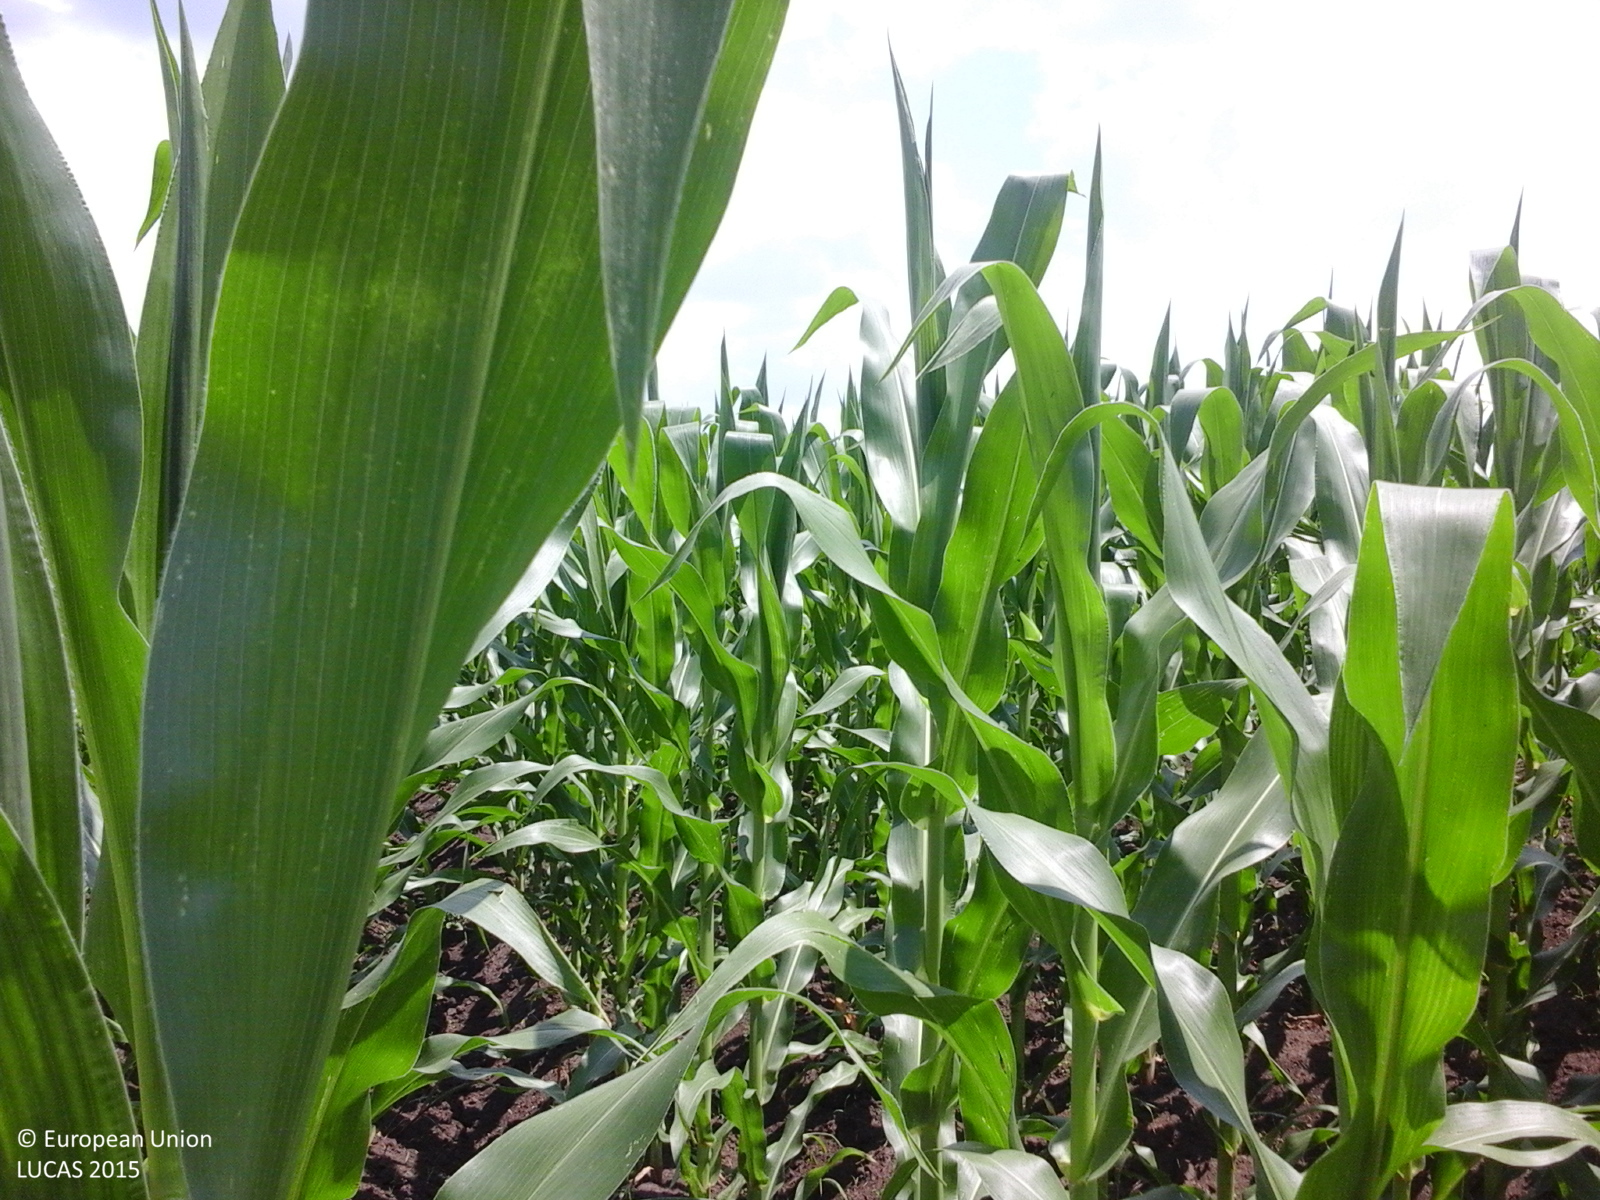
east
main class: Cropland
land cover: Maize
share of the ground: > 75 %
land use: Agriculture (excluding fallow land and kitchen gardens)
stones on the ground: < 10 %
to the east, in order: Maize
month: July
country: RO
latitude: 43.9867
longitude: 25.4844
